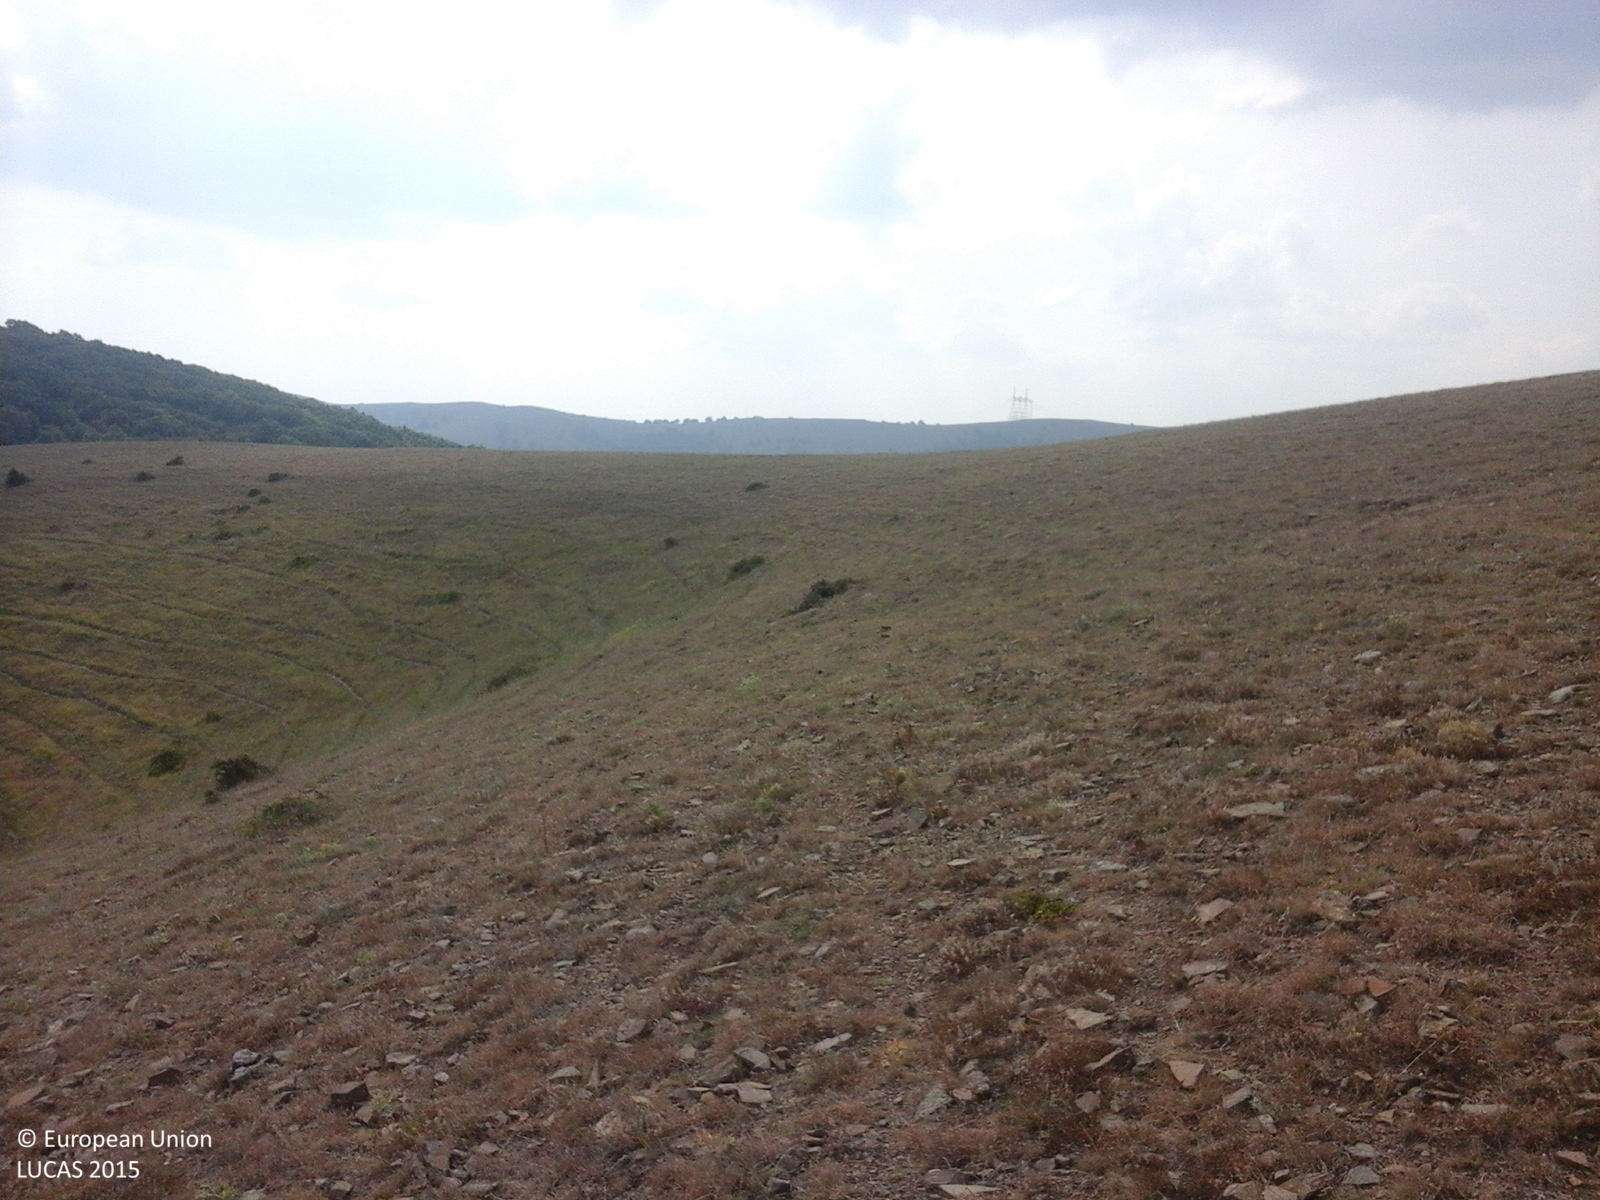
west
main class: Grassland
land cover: Grassland without tree/shrub cover
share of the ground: > 75 %
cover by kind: herbaceous plants 80 %, unconsolidated bare surface 20 %
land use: Agriculture (excluding fallow land and kitchen gardens)
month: July
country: RO
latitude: 45.0901
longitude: 28.4893
